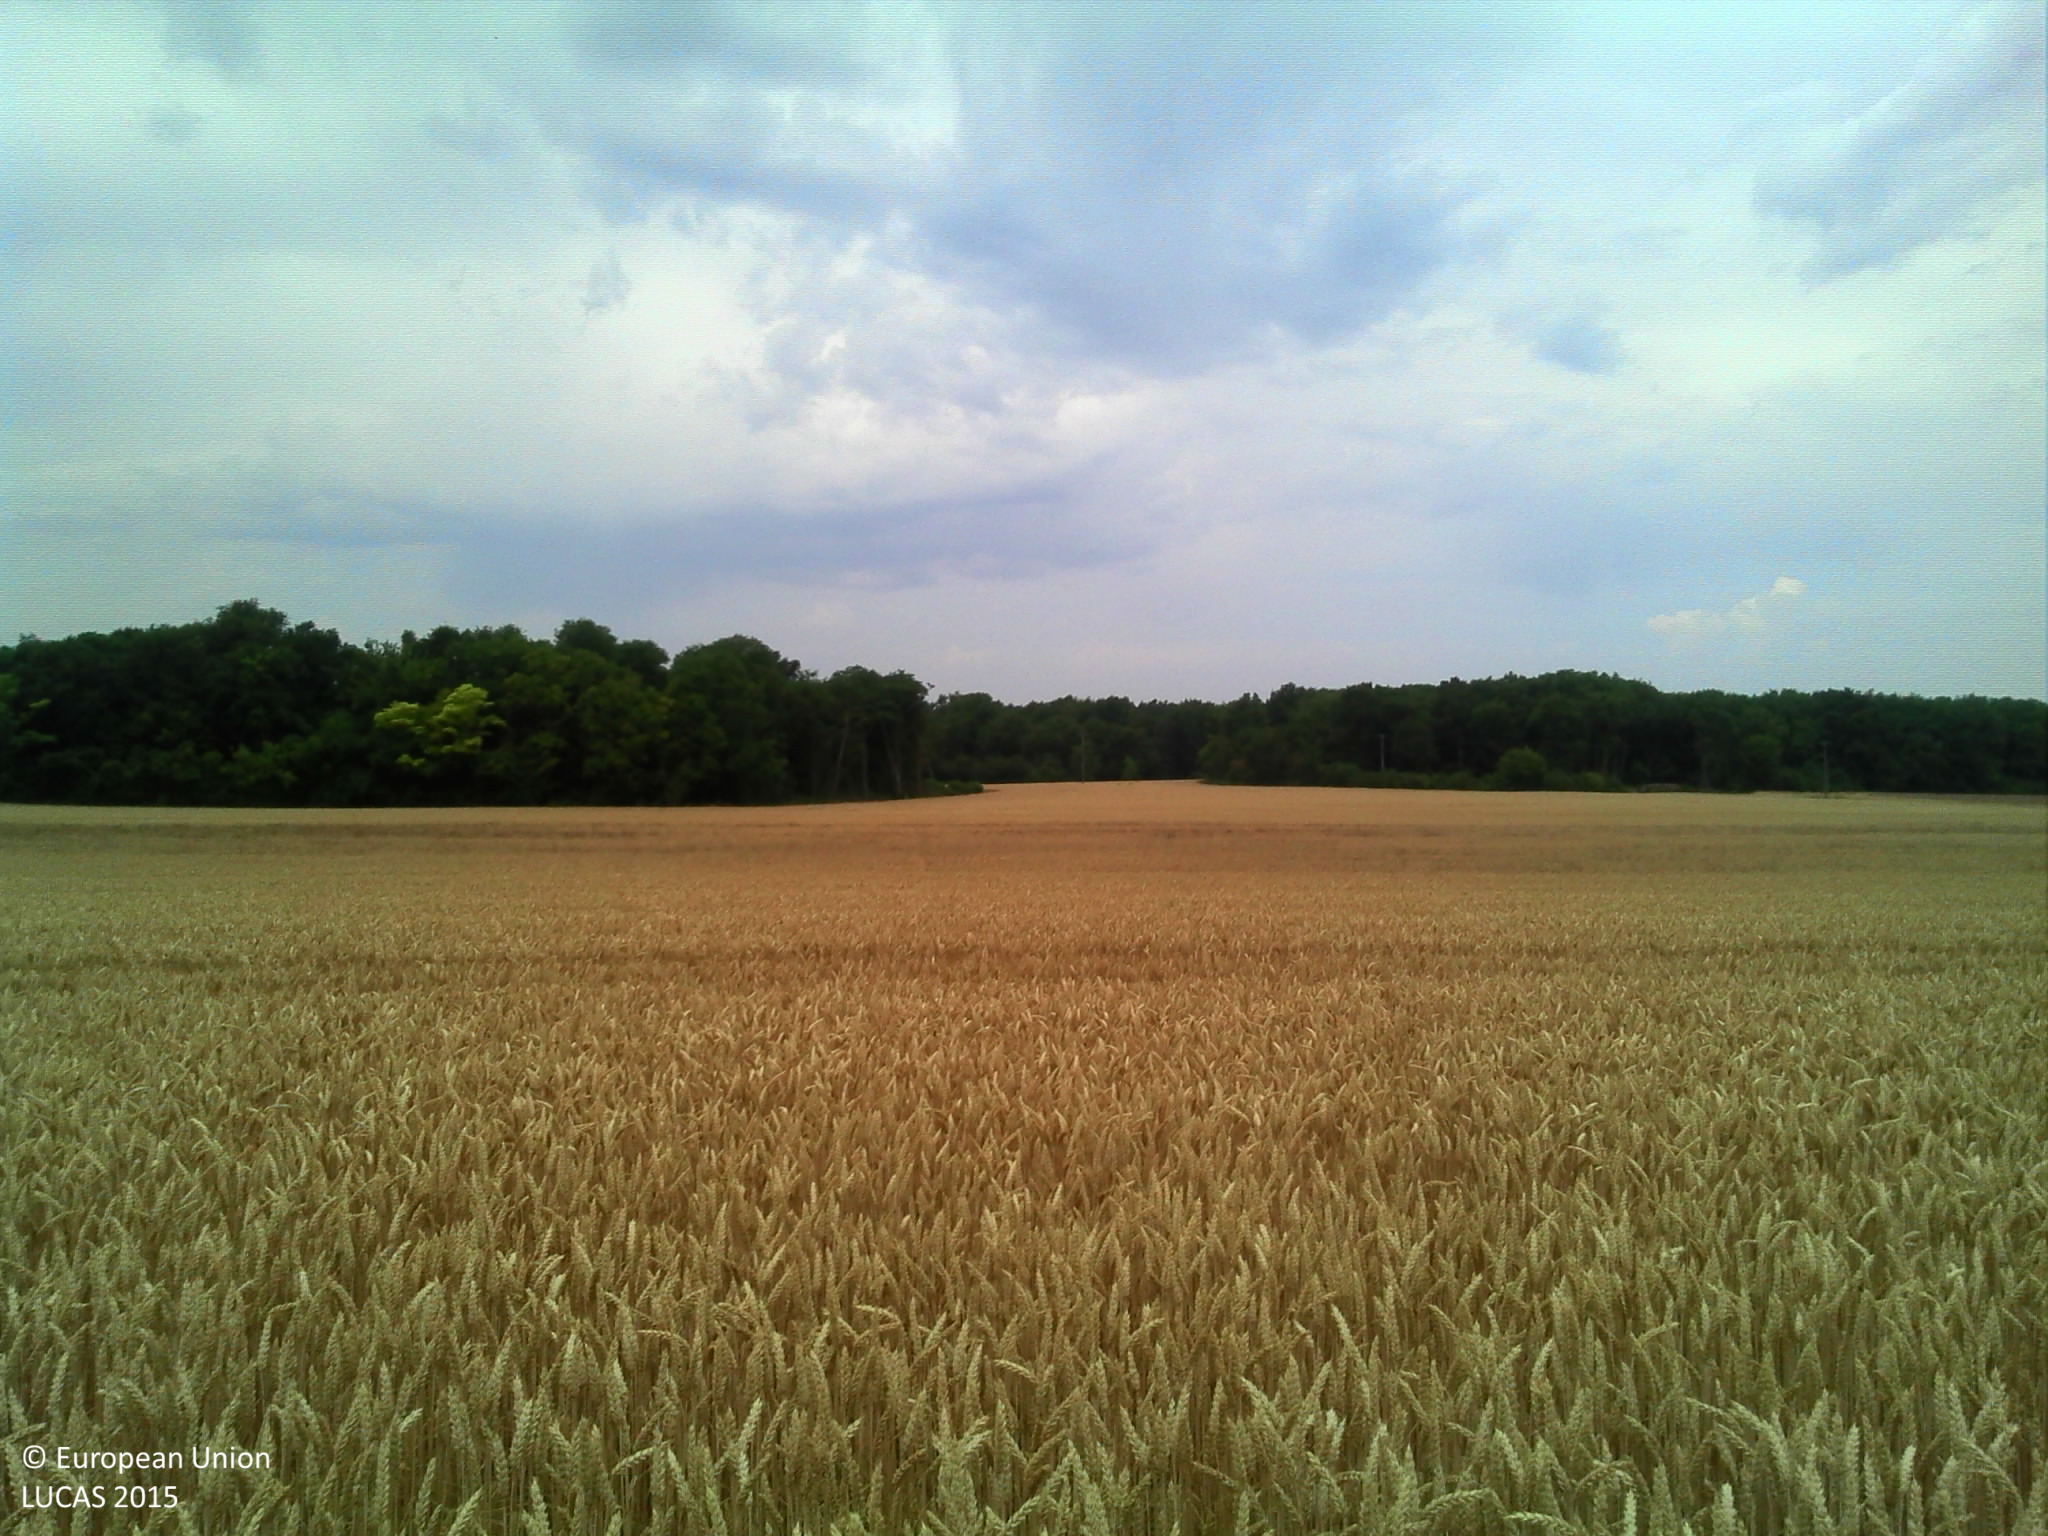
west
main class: Cropland
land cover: Common wheat
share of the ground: > 75 %
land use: Agriculture (excluding fallow land and kitchen gardens)
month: July
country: FR
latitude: 47.9323
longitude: 2.7775
